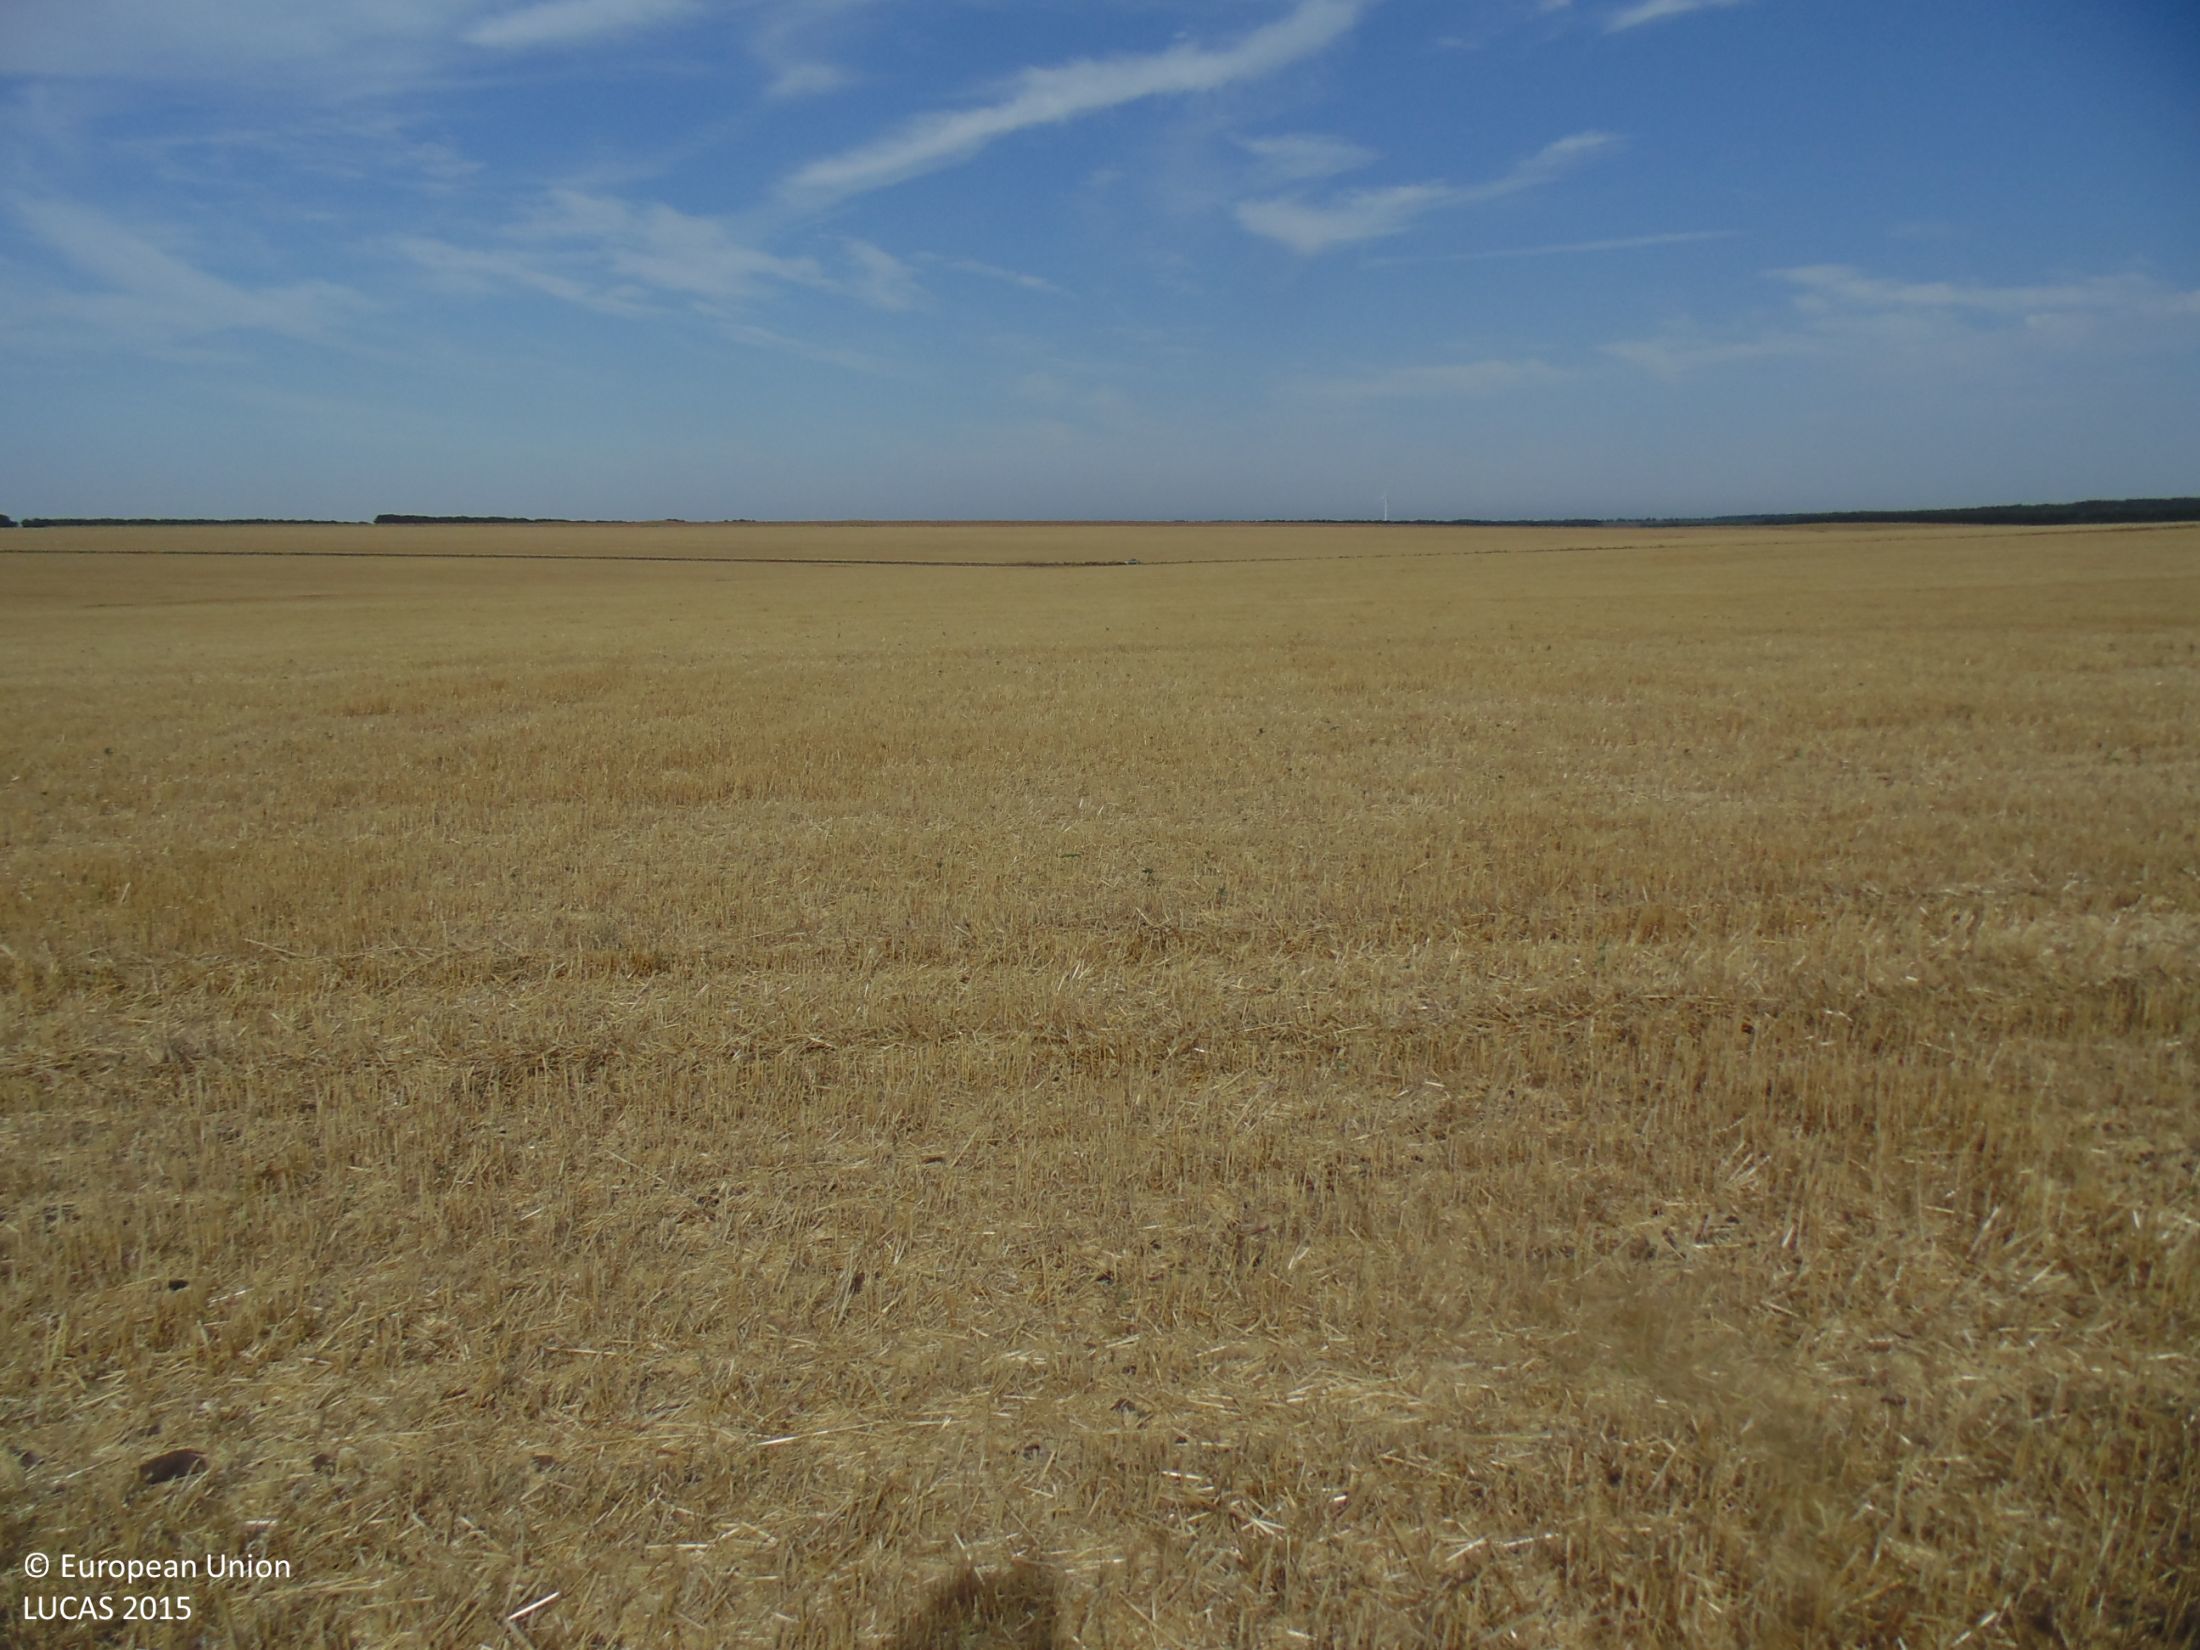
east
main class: Cropland
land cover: Common wheat
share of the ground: 25 - 50 %
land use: Agriculture (excluding fallow land and kitchen gardens)
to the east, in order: Common wheat
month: August
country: BG
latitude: 43.6396
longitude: 28.3429
